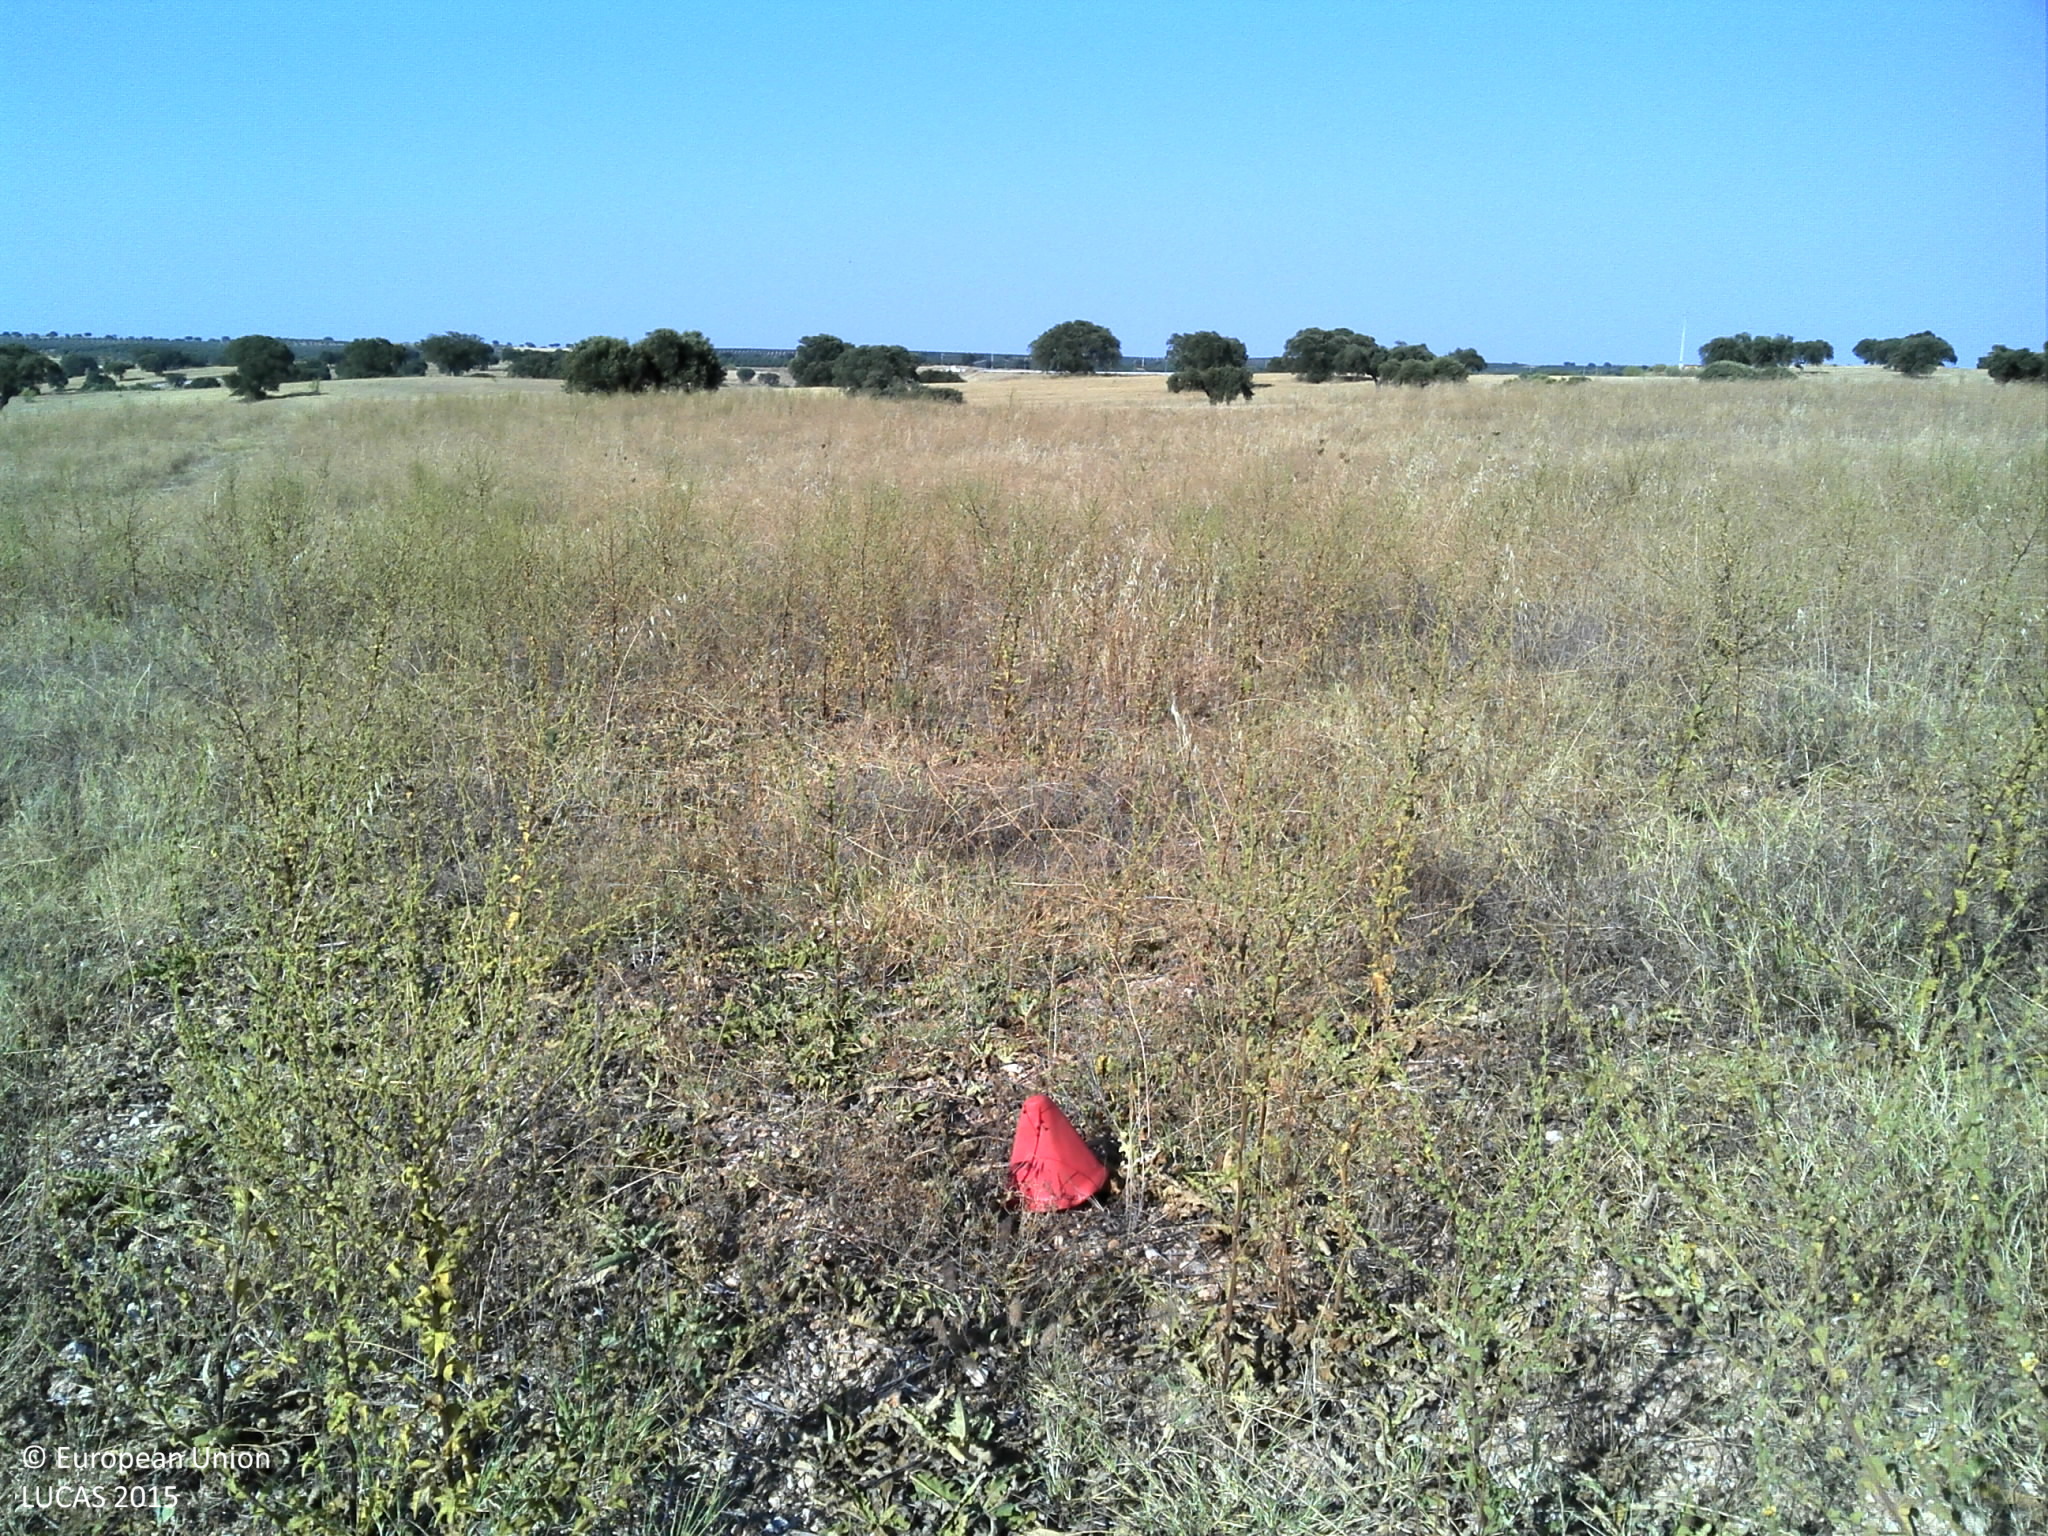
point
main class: Grassland
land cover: Spontaneously vegetated surfaces
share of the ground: > 75 %
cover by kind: herbaceous plants 80 %, unconsolidated bare surface 20 %
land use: Agriculture (excluding fallow land and kitchen gardens)
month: June
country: PT
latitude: 38.0947
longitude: -7.5712
